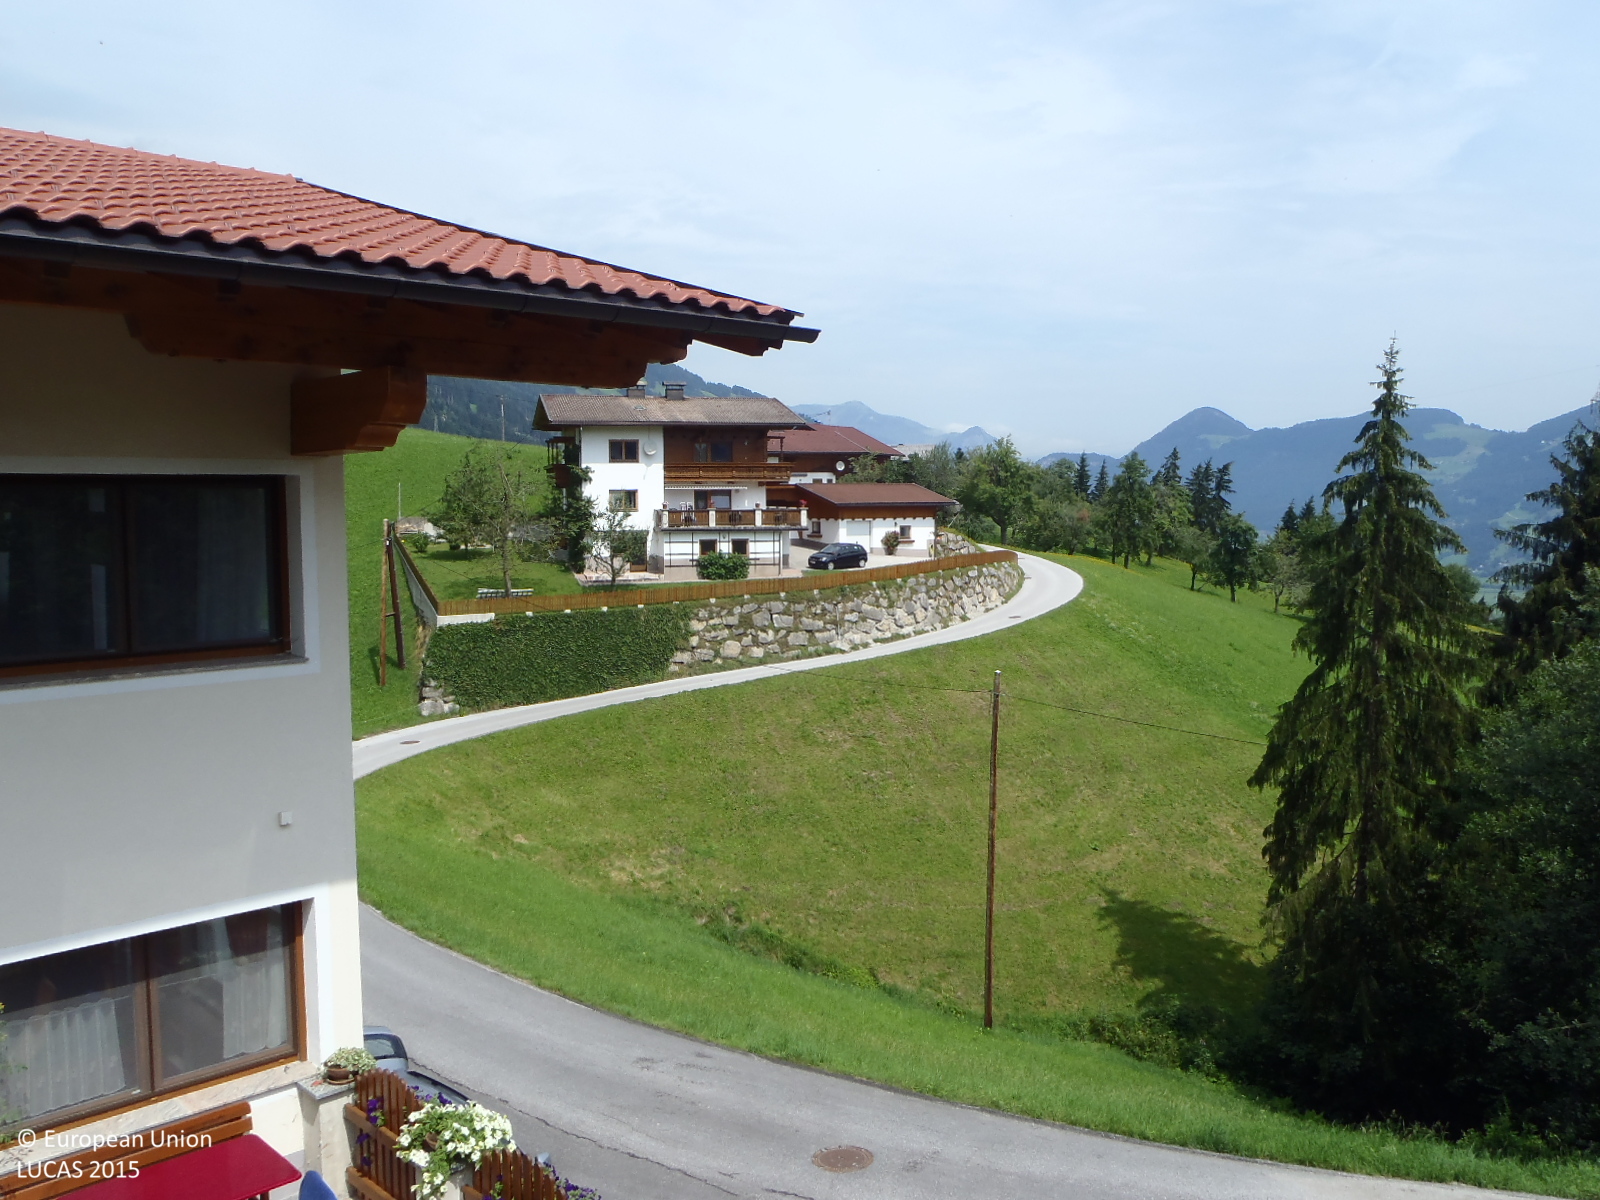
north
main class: Grassland
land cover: Grassland without tree/shrub cover
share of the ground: > 75 %
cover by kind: herbaceous plants 100 %
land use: Agriculture (excluding fallow land and kitchen gardens)
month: July
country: AT
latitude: 47.3261
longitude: 11.8377
